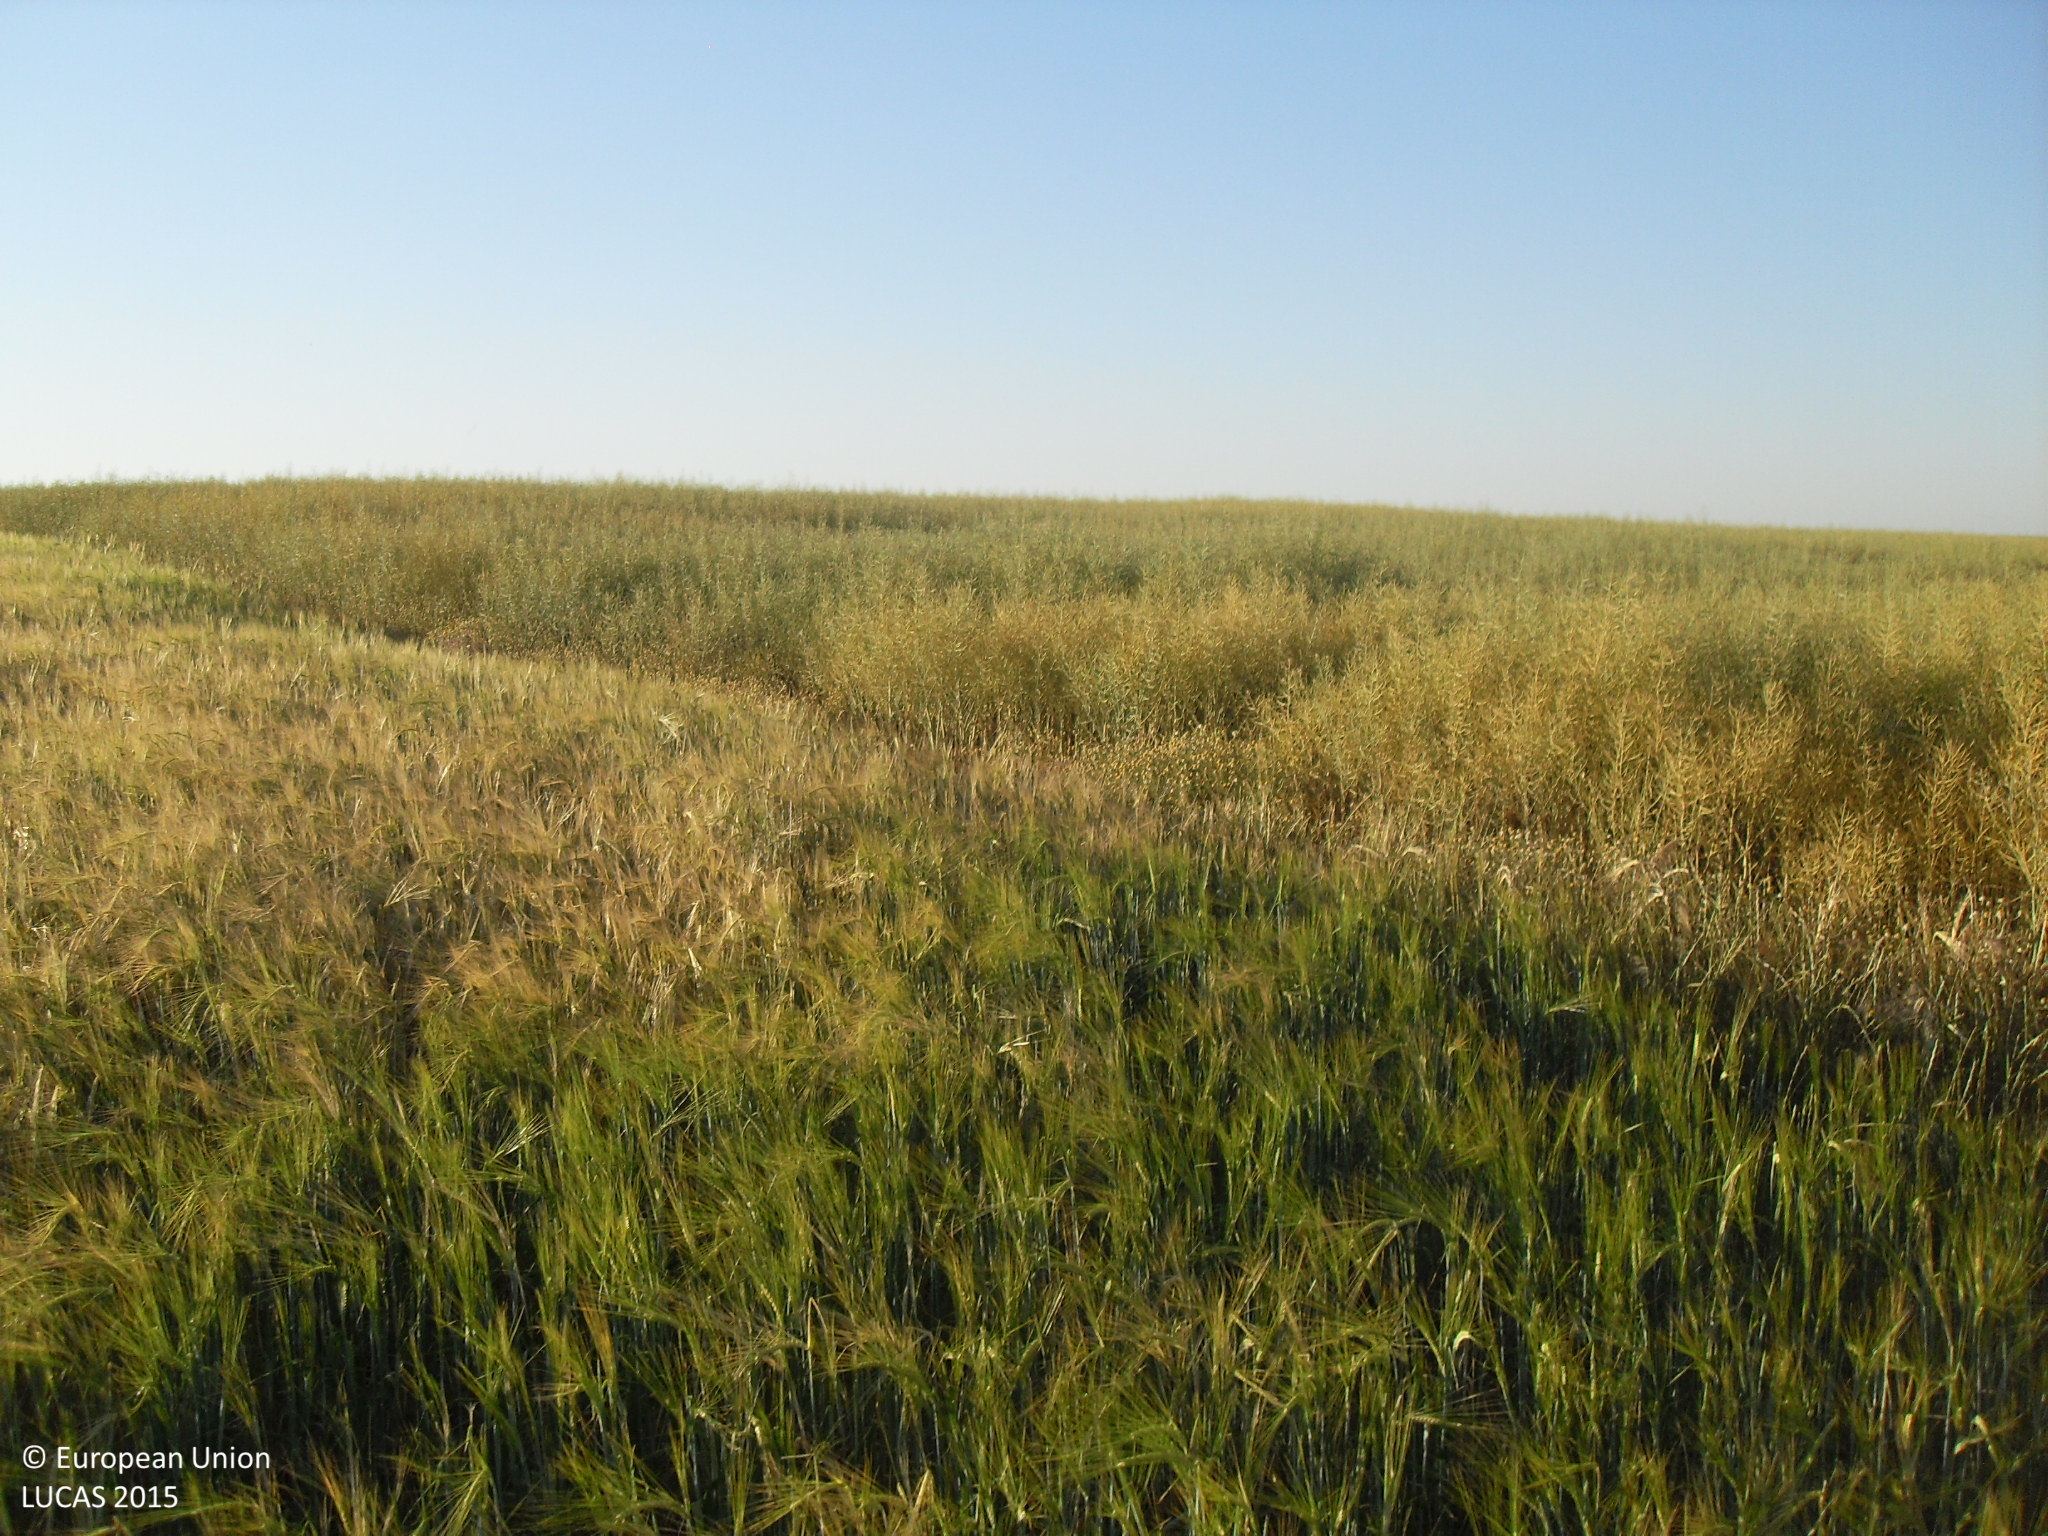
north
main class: Cropland
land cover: Barley
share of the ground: > 75 %
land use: Agriculture (excluding fallow land and kitchen gardens)
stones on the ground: 25 - 50 %
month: May
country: ES
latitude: 41.0659
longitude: -5.3891
